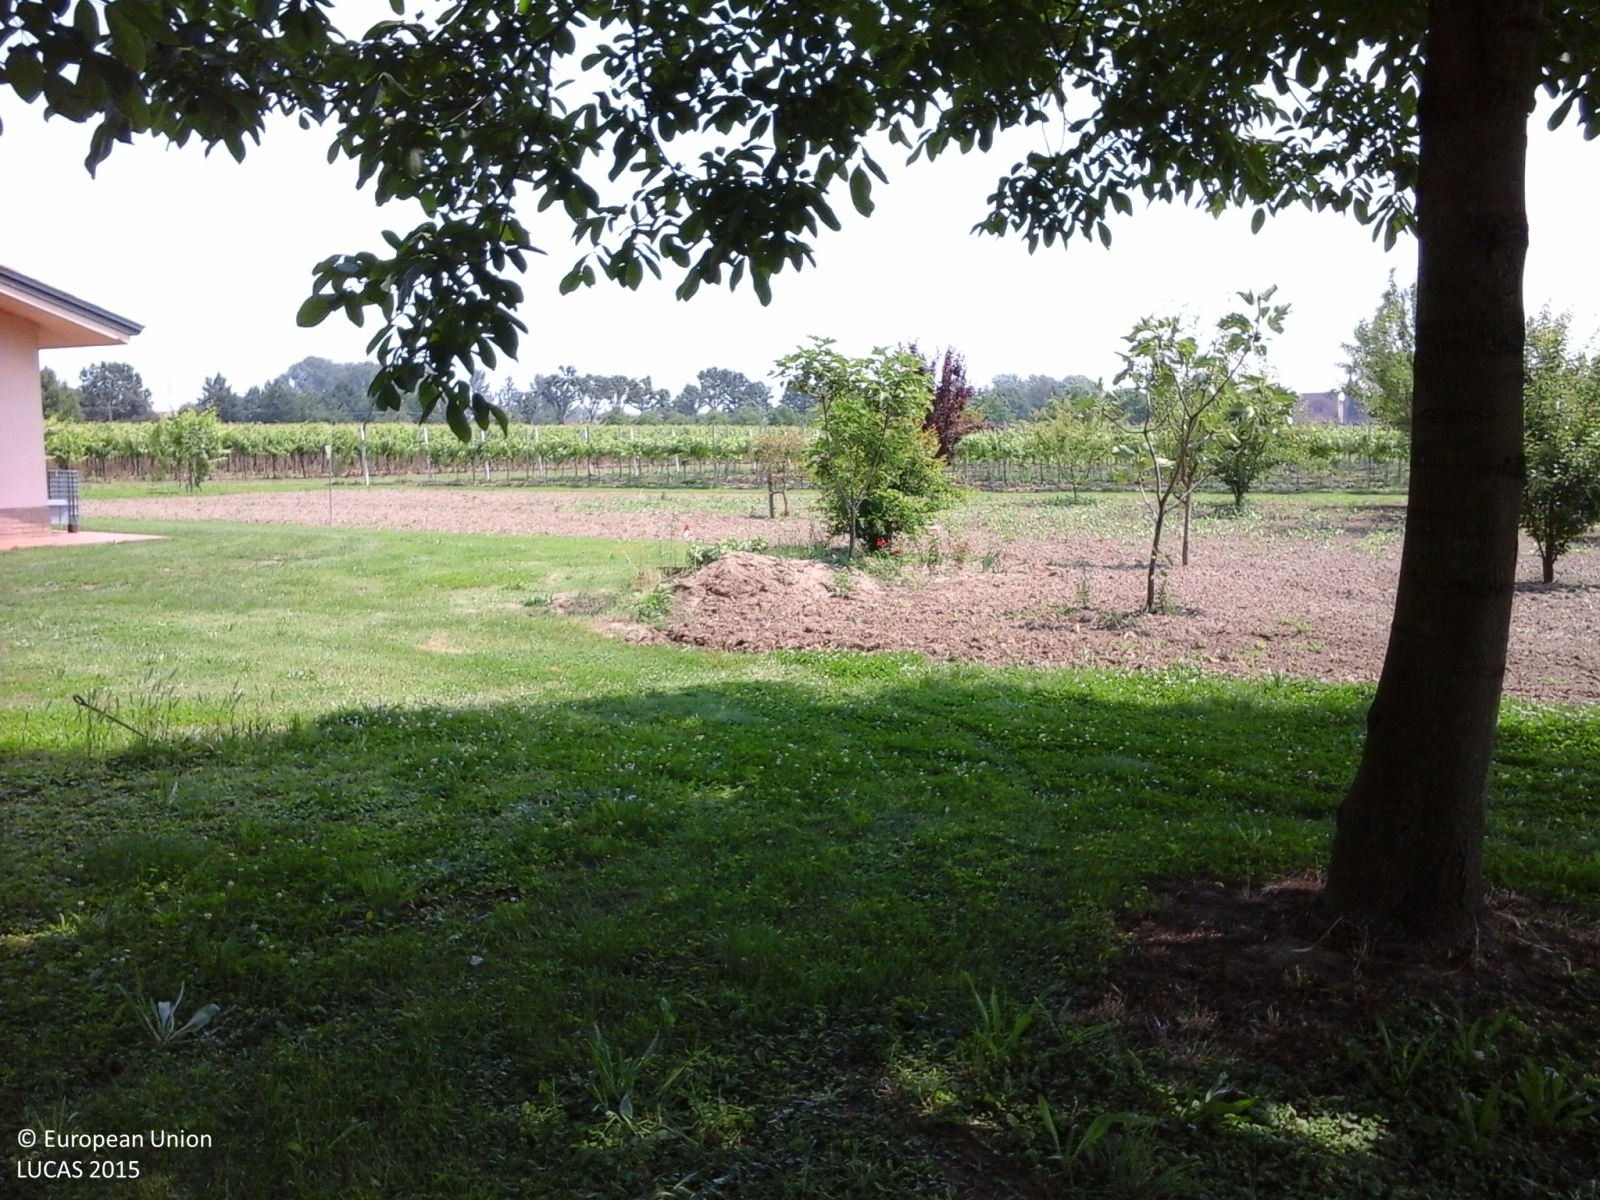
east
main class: Woodland
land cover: Broadleaved woodland
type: thermophilous deciduous forest
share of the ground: 50 - 75 %
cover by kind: herbaceous plants 85 %, broadleaved forest trees 15 %
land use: Residential
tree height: > 5 m
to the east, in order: Broadleaved woodland; Other bare soil; Vineyards; Ditches and canals; Vineyards; Maize
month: May
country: IT
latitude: 44.7803
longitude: 10.7945
